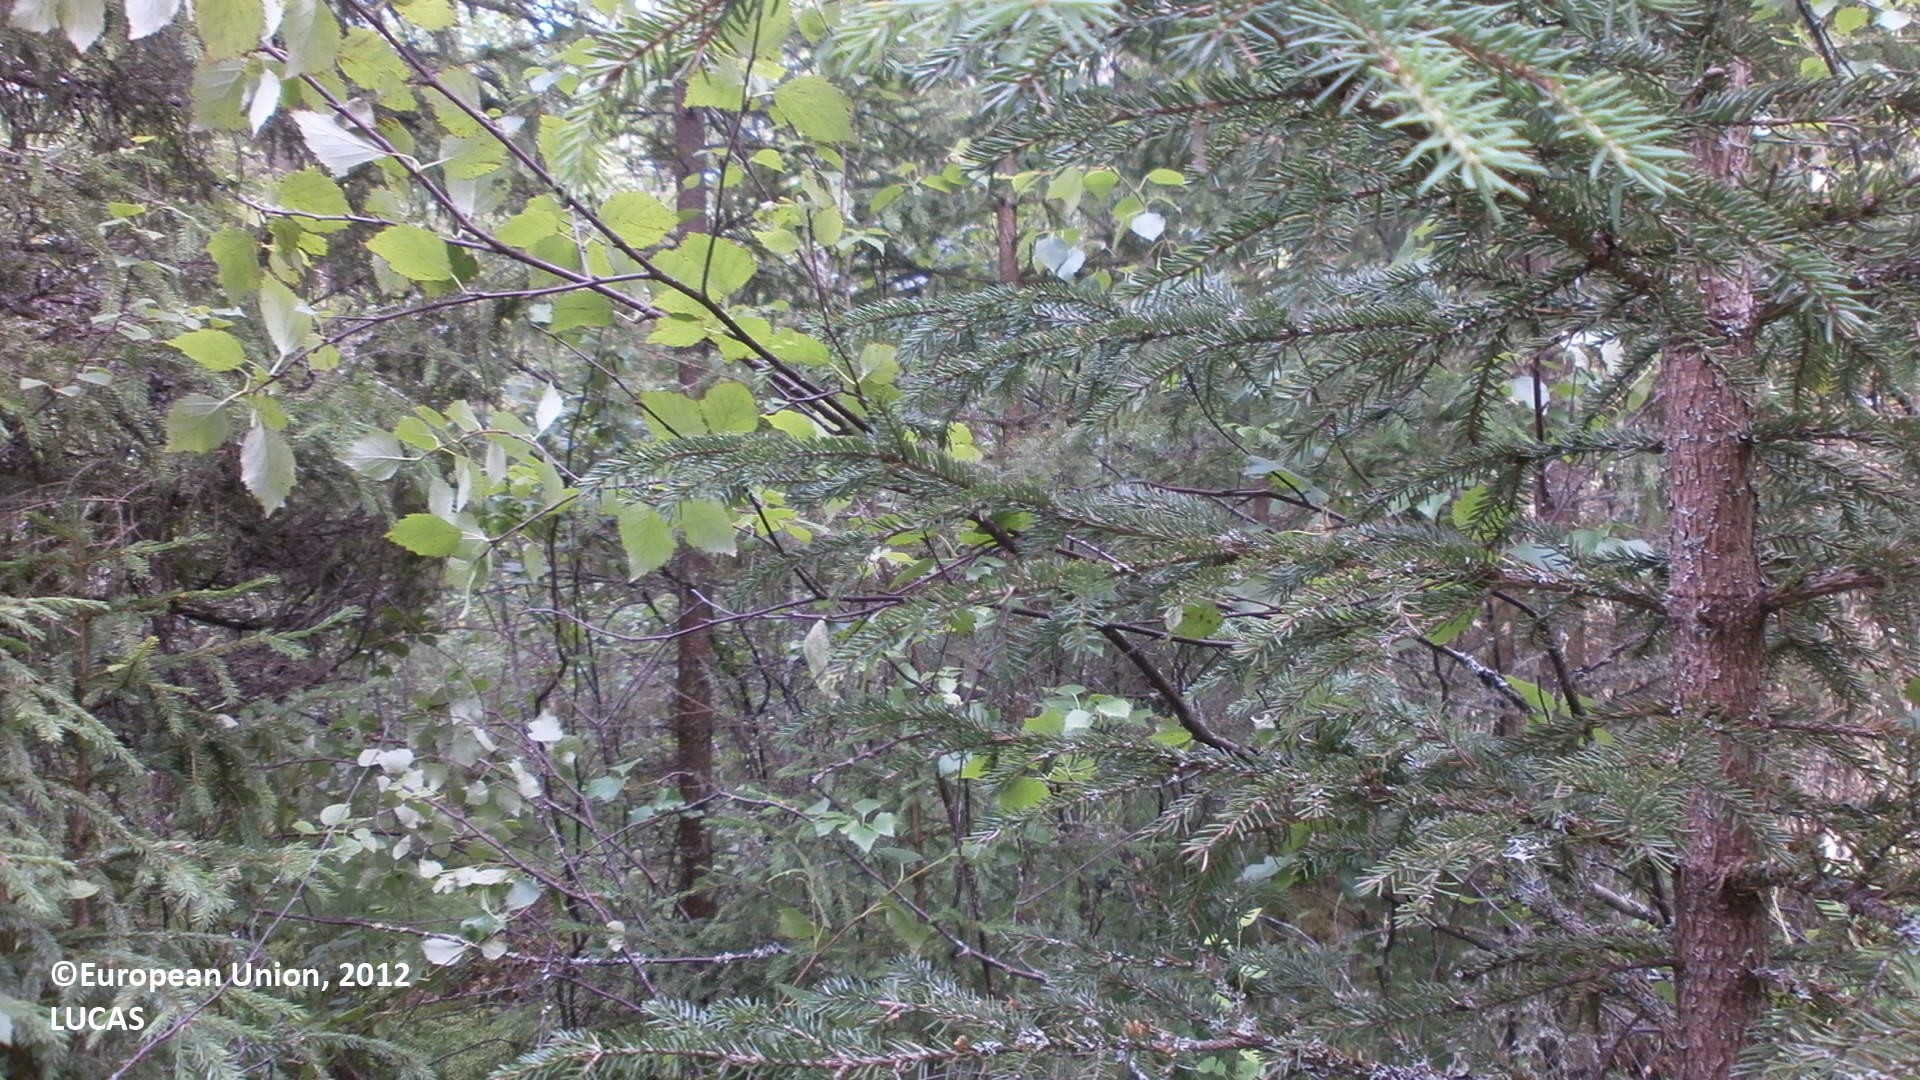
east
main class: Woodland
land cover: Spruce dominated mixed woodland
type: boreal forest
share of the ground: 50 - 75 %
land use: Forestry
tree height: > 5 m
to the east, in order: Spruce dominated mixed woodland; Ditches and canals; Spruce dominated mixed woodland; Pine dominated mixed woodland
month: July
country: FI
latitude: 64.3369
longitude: 24.2846
